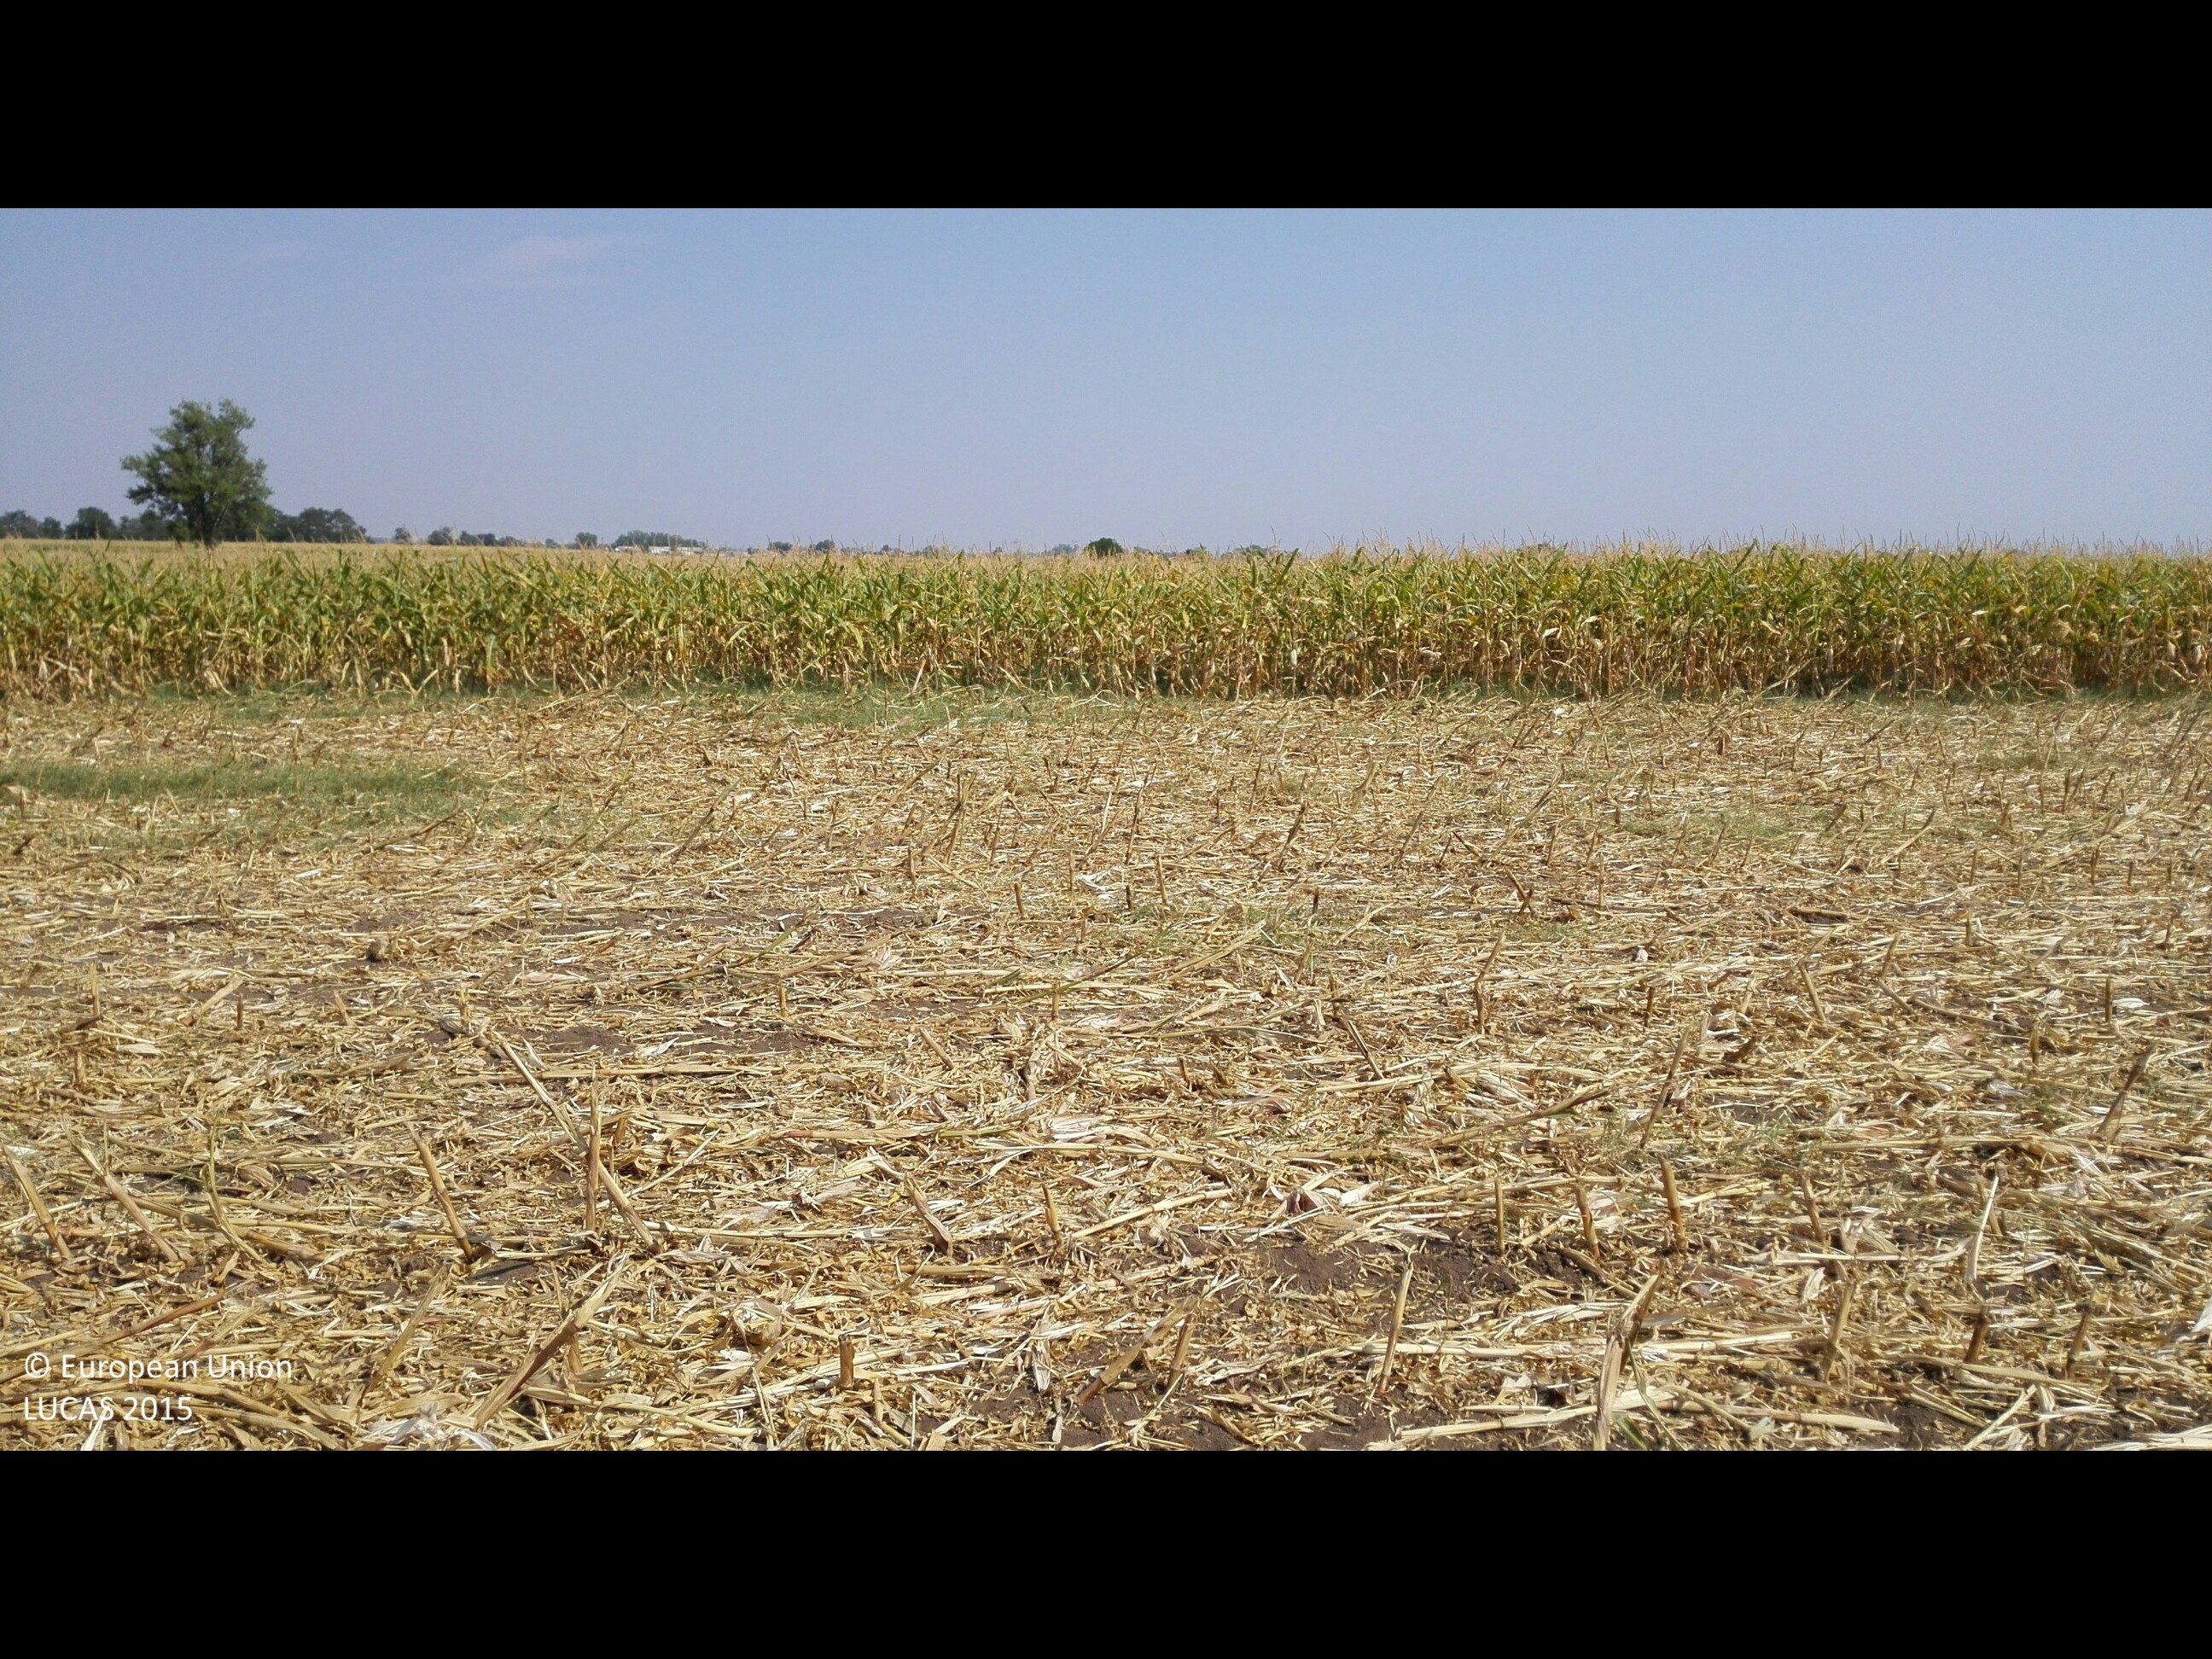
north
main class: Cropland
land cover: Maize
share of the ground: 10 - 25 %
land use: Agriculture (excluding fallow land and kitchen gardens)
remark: Harvested field
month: August
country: HU
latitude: 47.4607
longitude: 21.6249
